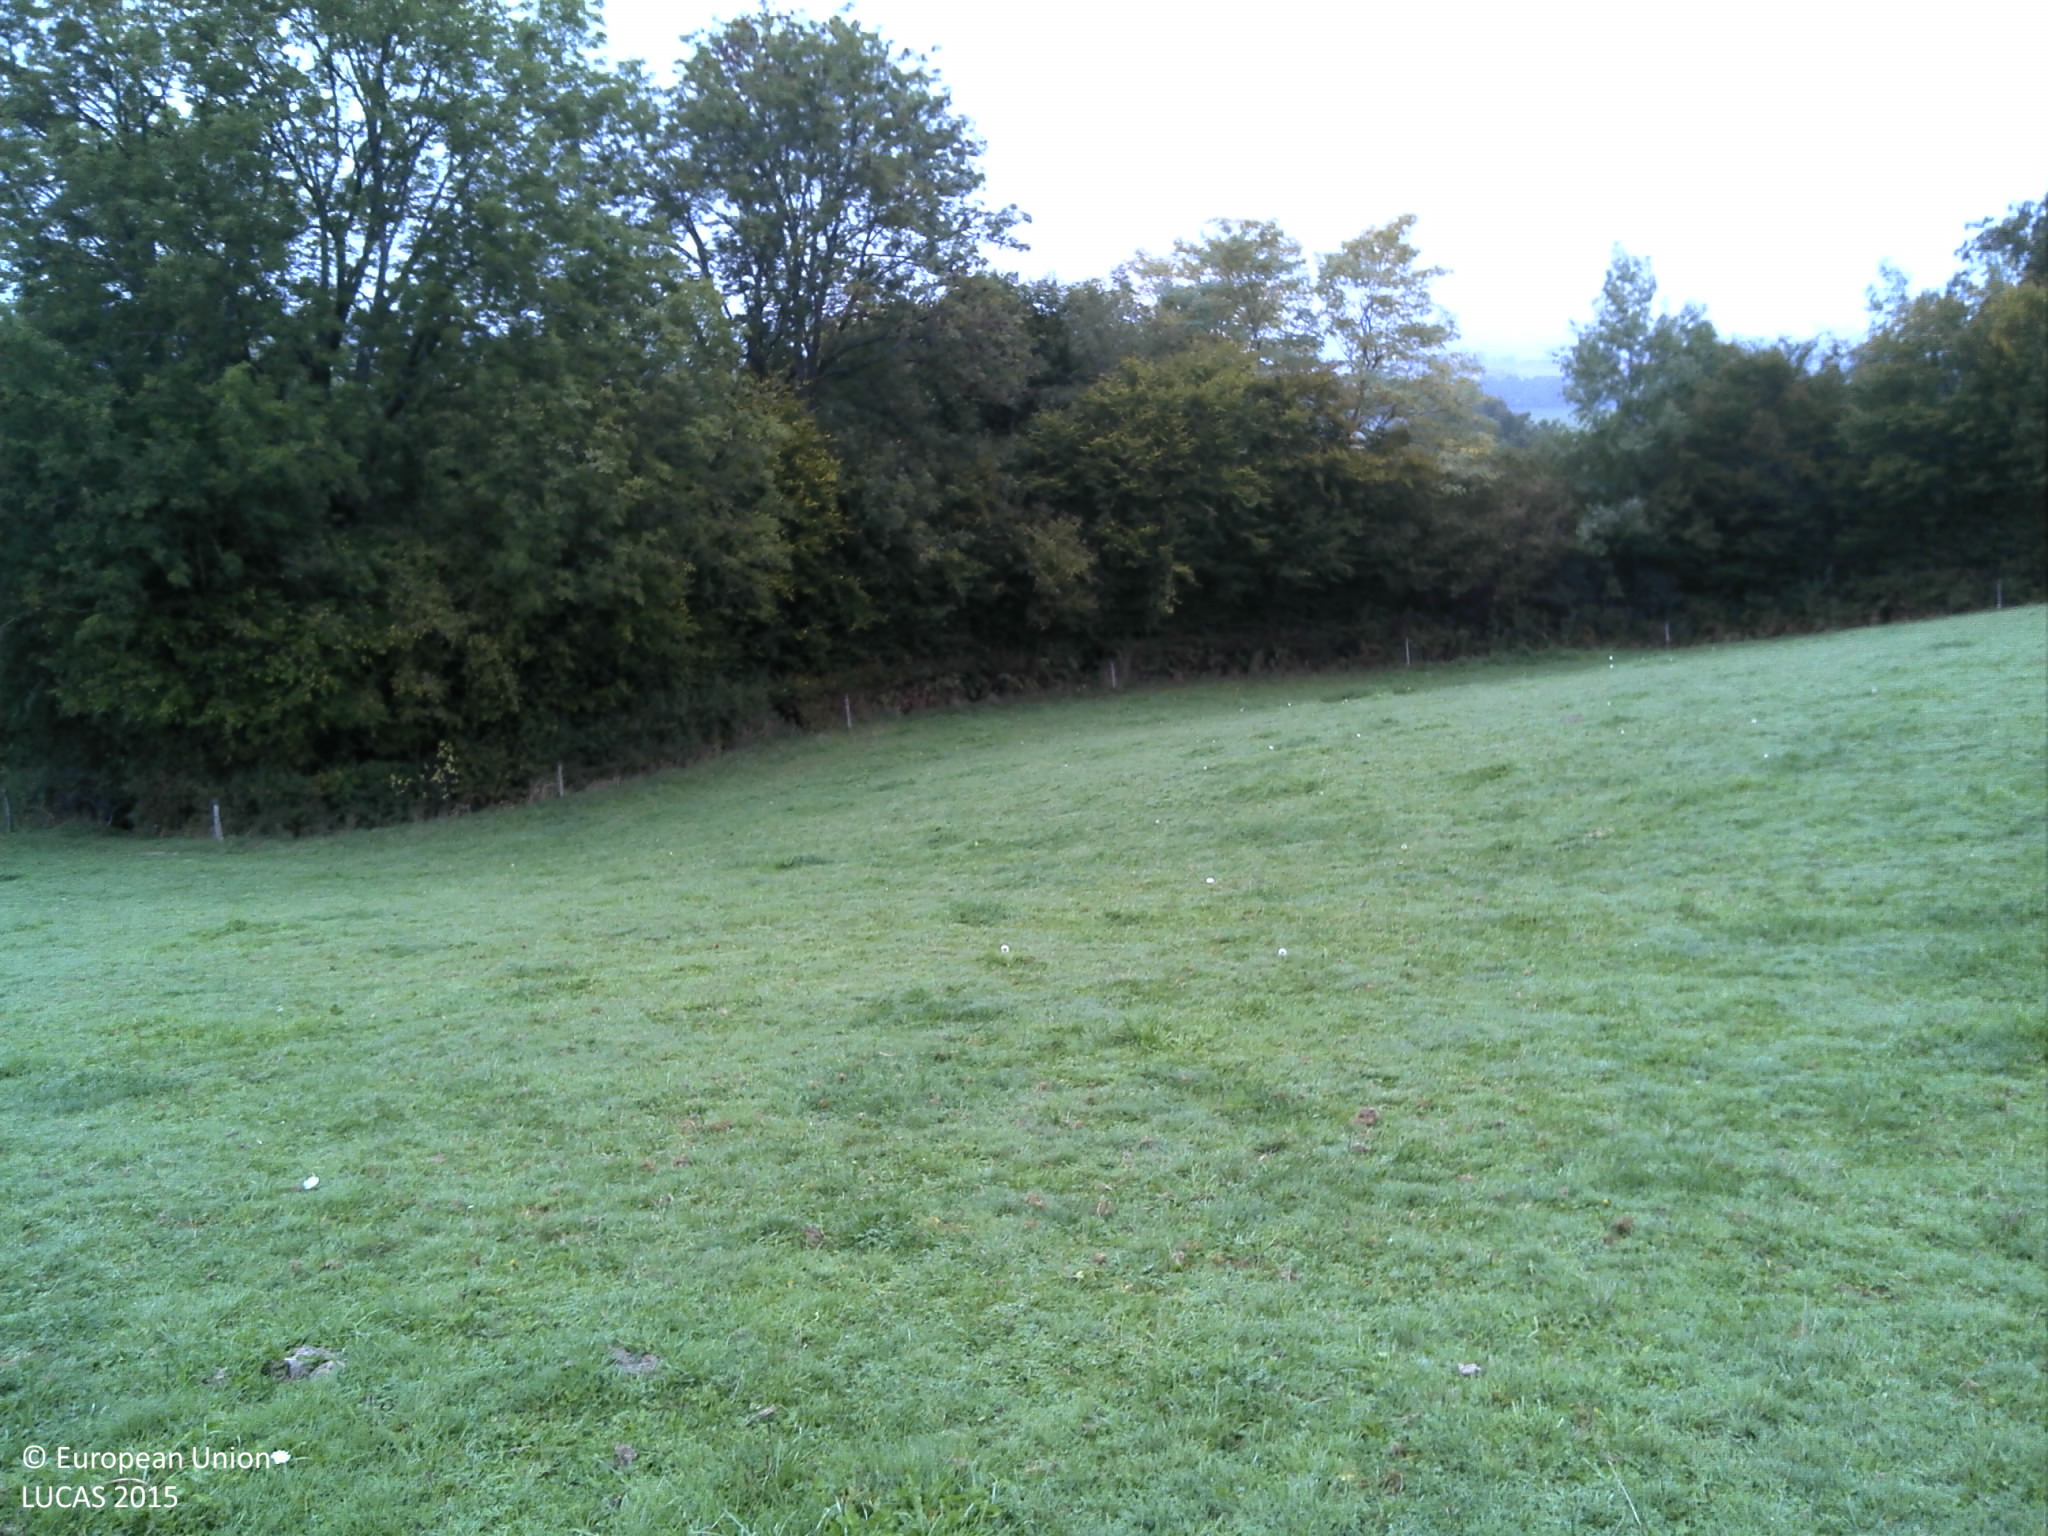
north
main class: Grassland
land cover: Grassland without tree/shrub cover
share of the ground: > 75 %
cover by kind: herbaceous plants 100 %
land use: Agriculture (excluding fallow land and kitchen gardens)
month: October
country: FR
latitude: 46.6868
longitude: 3.9721
